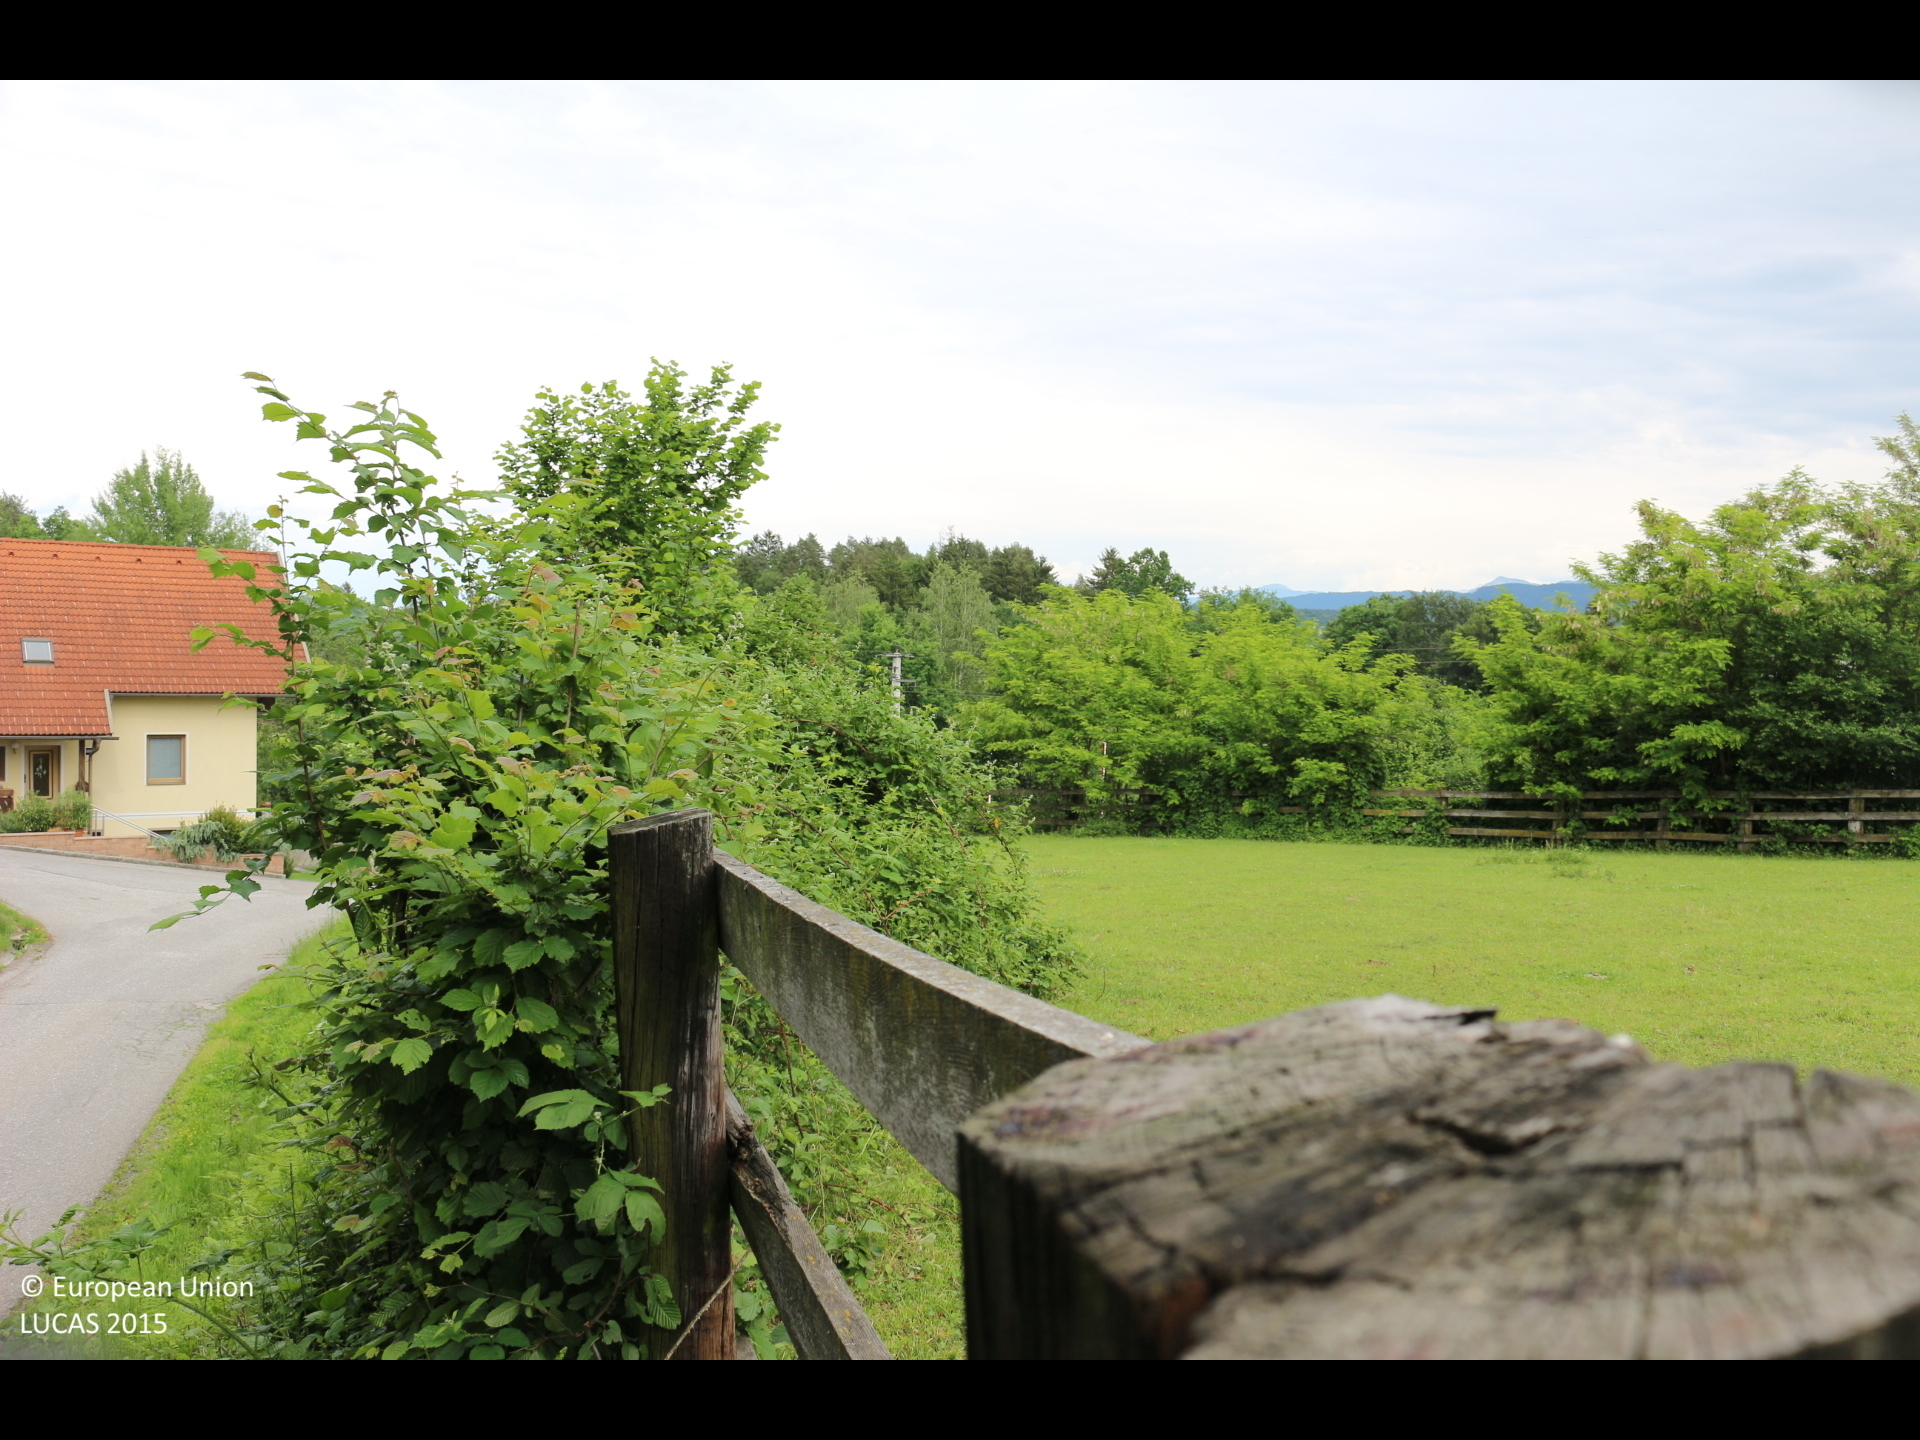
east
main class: Grassland
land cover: Grassland without tree/shrub cover
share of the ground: > 75 %
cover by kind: herbaceous plants 100 %
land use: Agriculture (excluding fallow land and kitchen gardens)
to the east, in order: Grassland without tree/shrub cover; Fences; Shrubland with sparse tree cover; Paved roads, cycling and walking lanes; Grass margins; Fences; Broadleaved woodland; Conifer hedges; Grassland without tree/shrub cover; Artificial constructions; Railways; Artificial constructions; Broadleaved woodland; Artificial constructions in urban areas; Grassland without tree/shrub cover
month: May
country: AT
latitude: 46.6178
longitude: 14.0323
